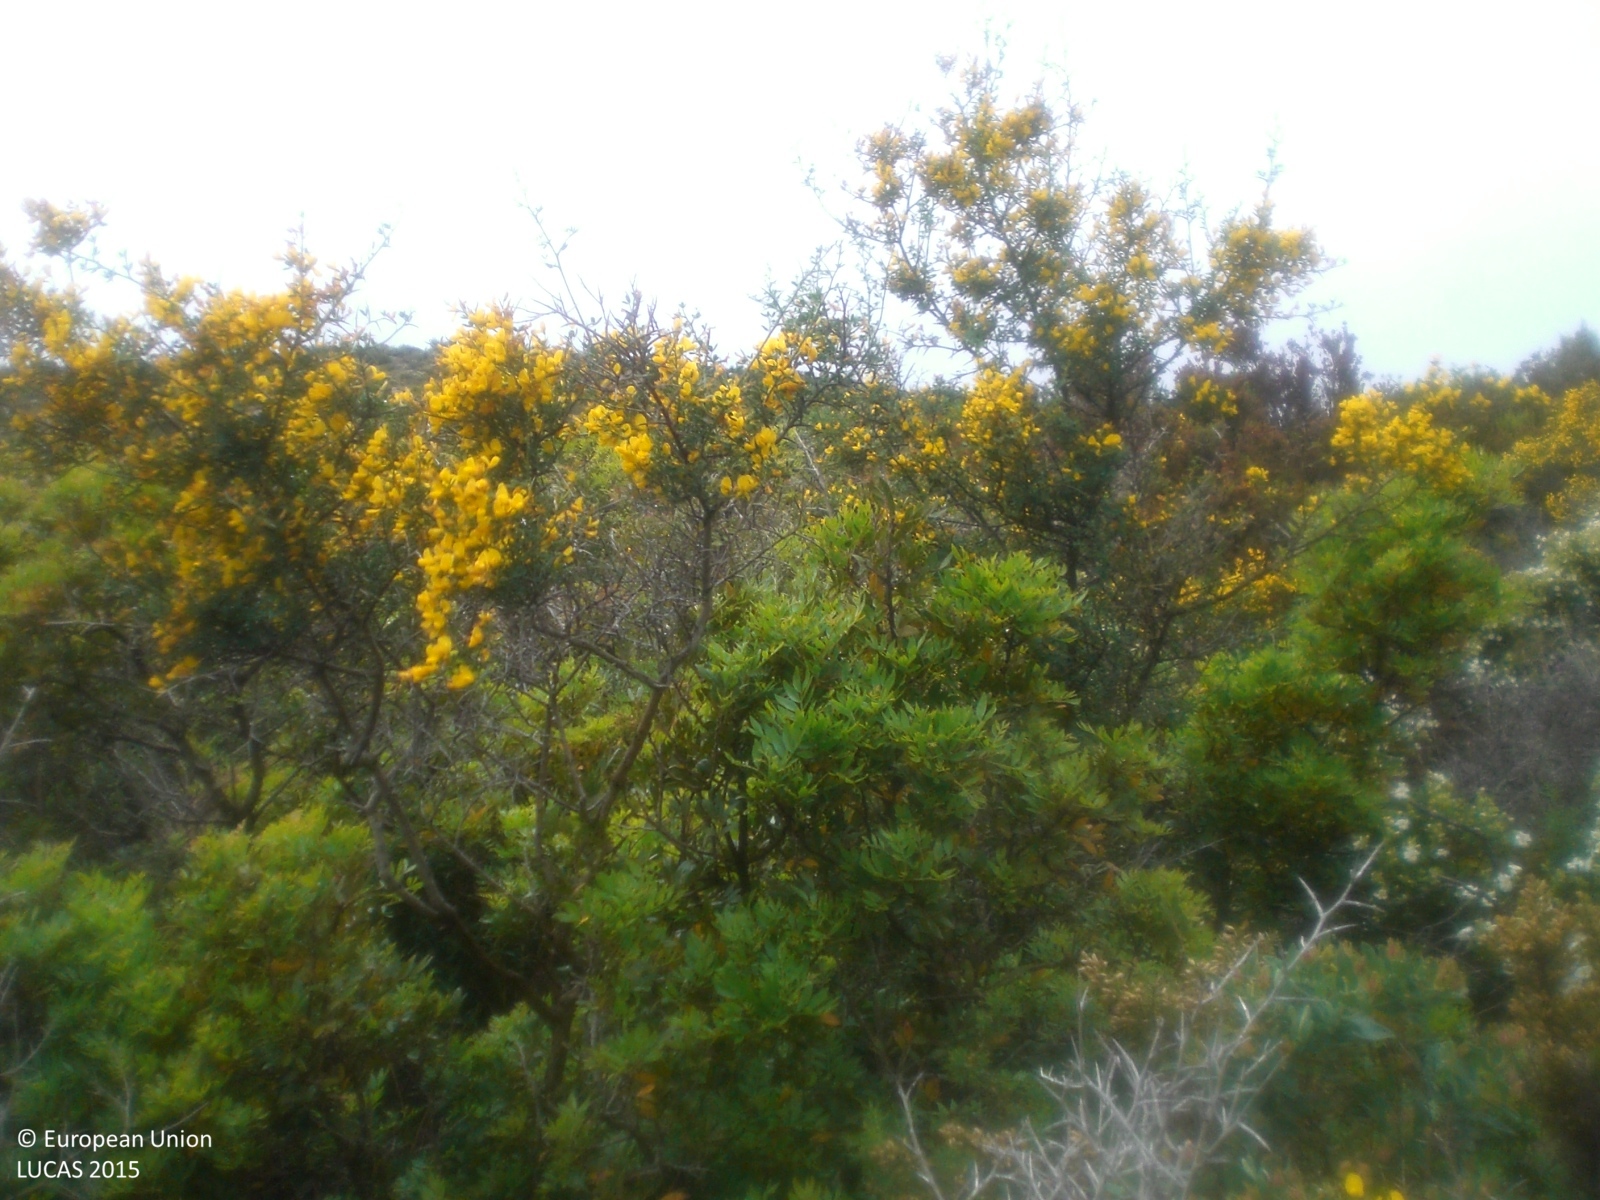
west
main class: Shrubland
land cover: Shrubland with sparse tree cover
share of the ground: > 75 %
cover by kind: shrubs 95 %, broadleaved forest trees 5 %
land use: Semi-natural and natural areas not in use
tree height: < 5 m
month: May
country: ES
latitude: 42.2632
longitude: 3.2136
